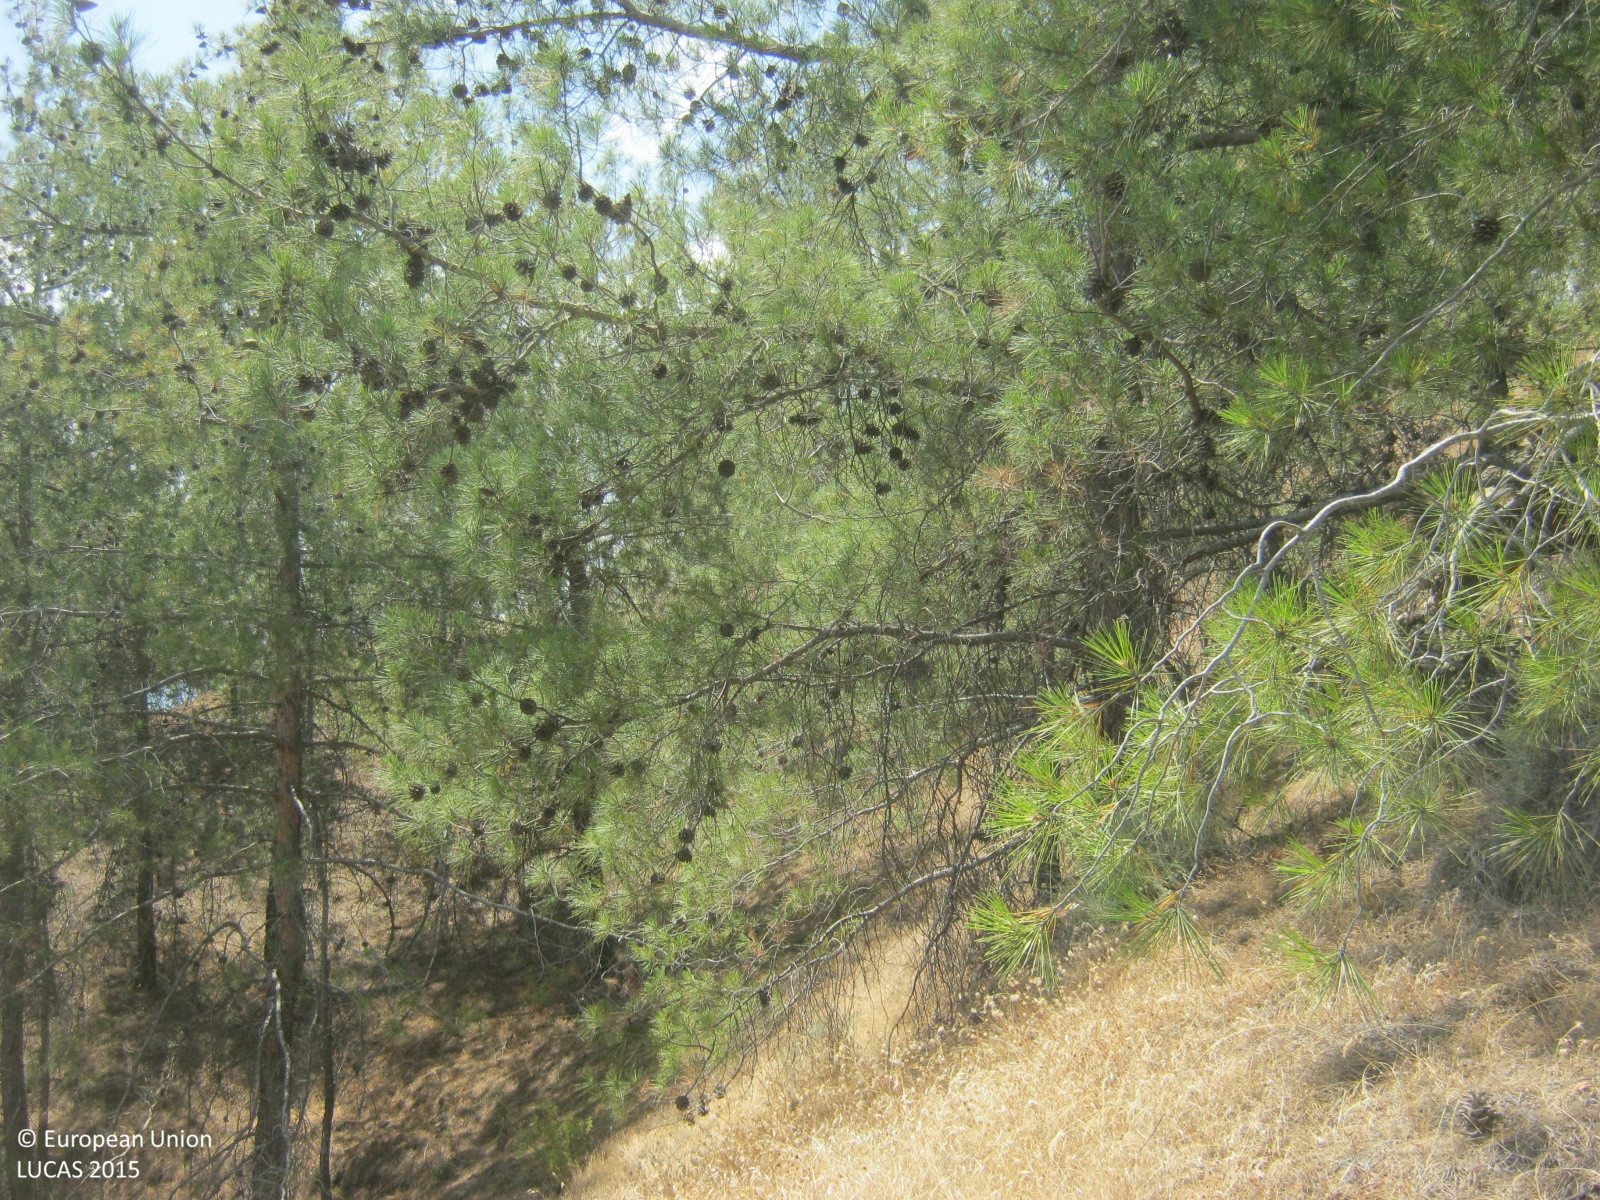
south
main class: Woodland
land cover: Pine dominated coniferous woodland
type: coniferous forest of the mediterranean region
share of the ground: > 75 %
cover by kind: coniferous forest trees 80 %, shrubs 10 %, unconsolidated bare surface 10 %
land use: Forestry
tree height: > 5 m
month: June
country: CY
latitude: 35.0183
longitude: 33.0026
